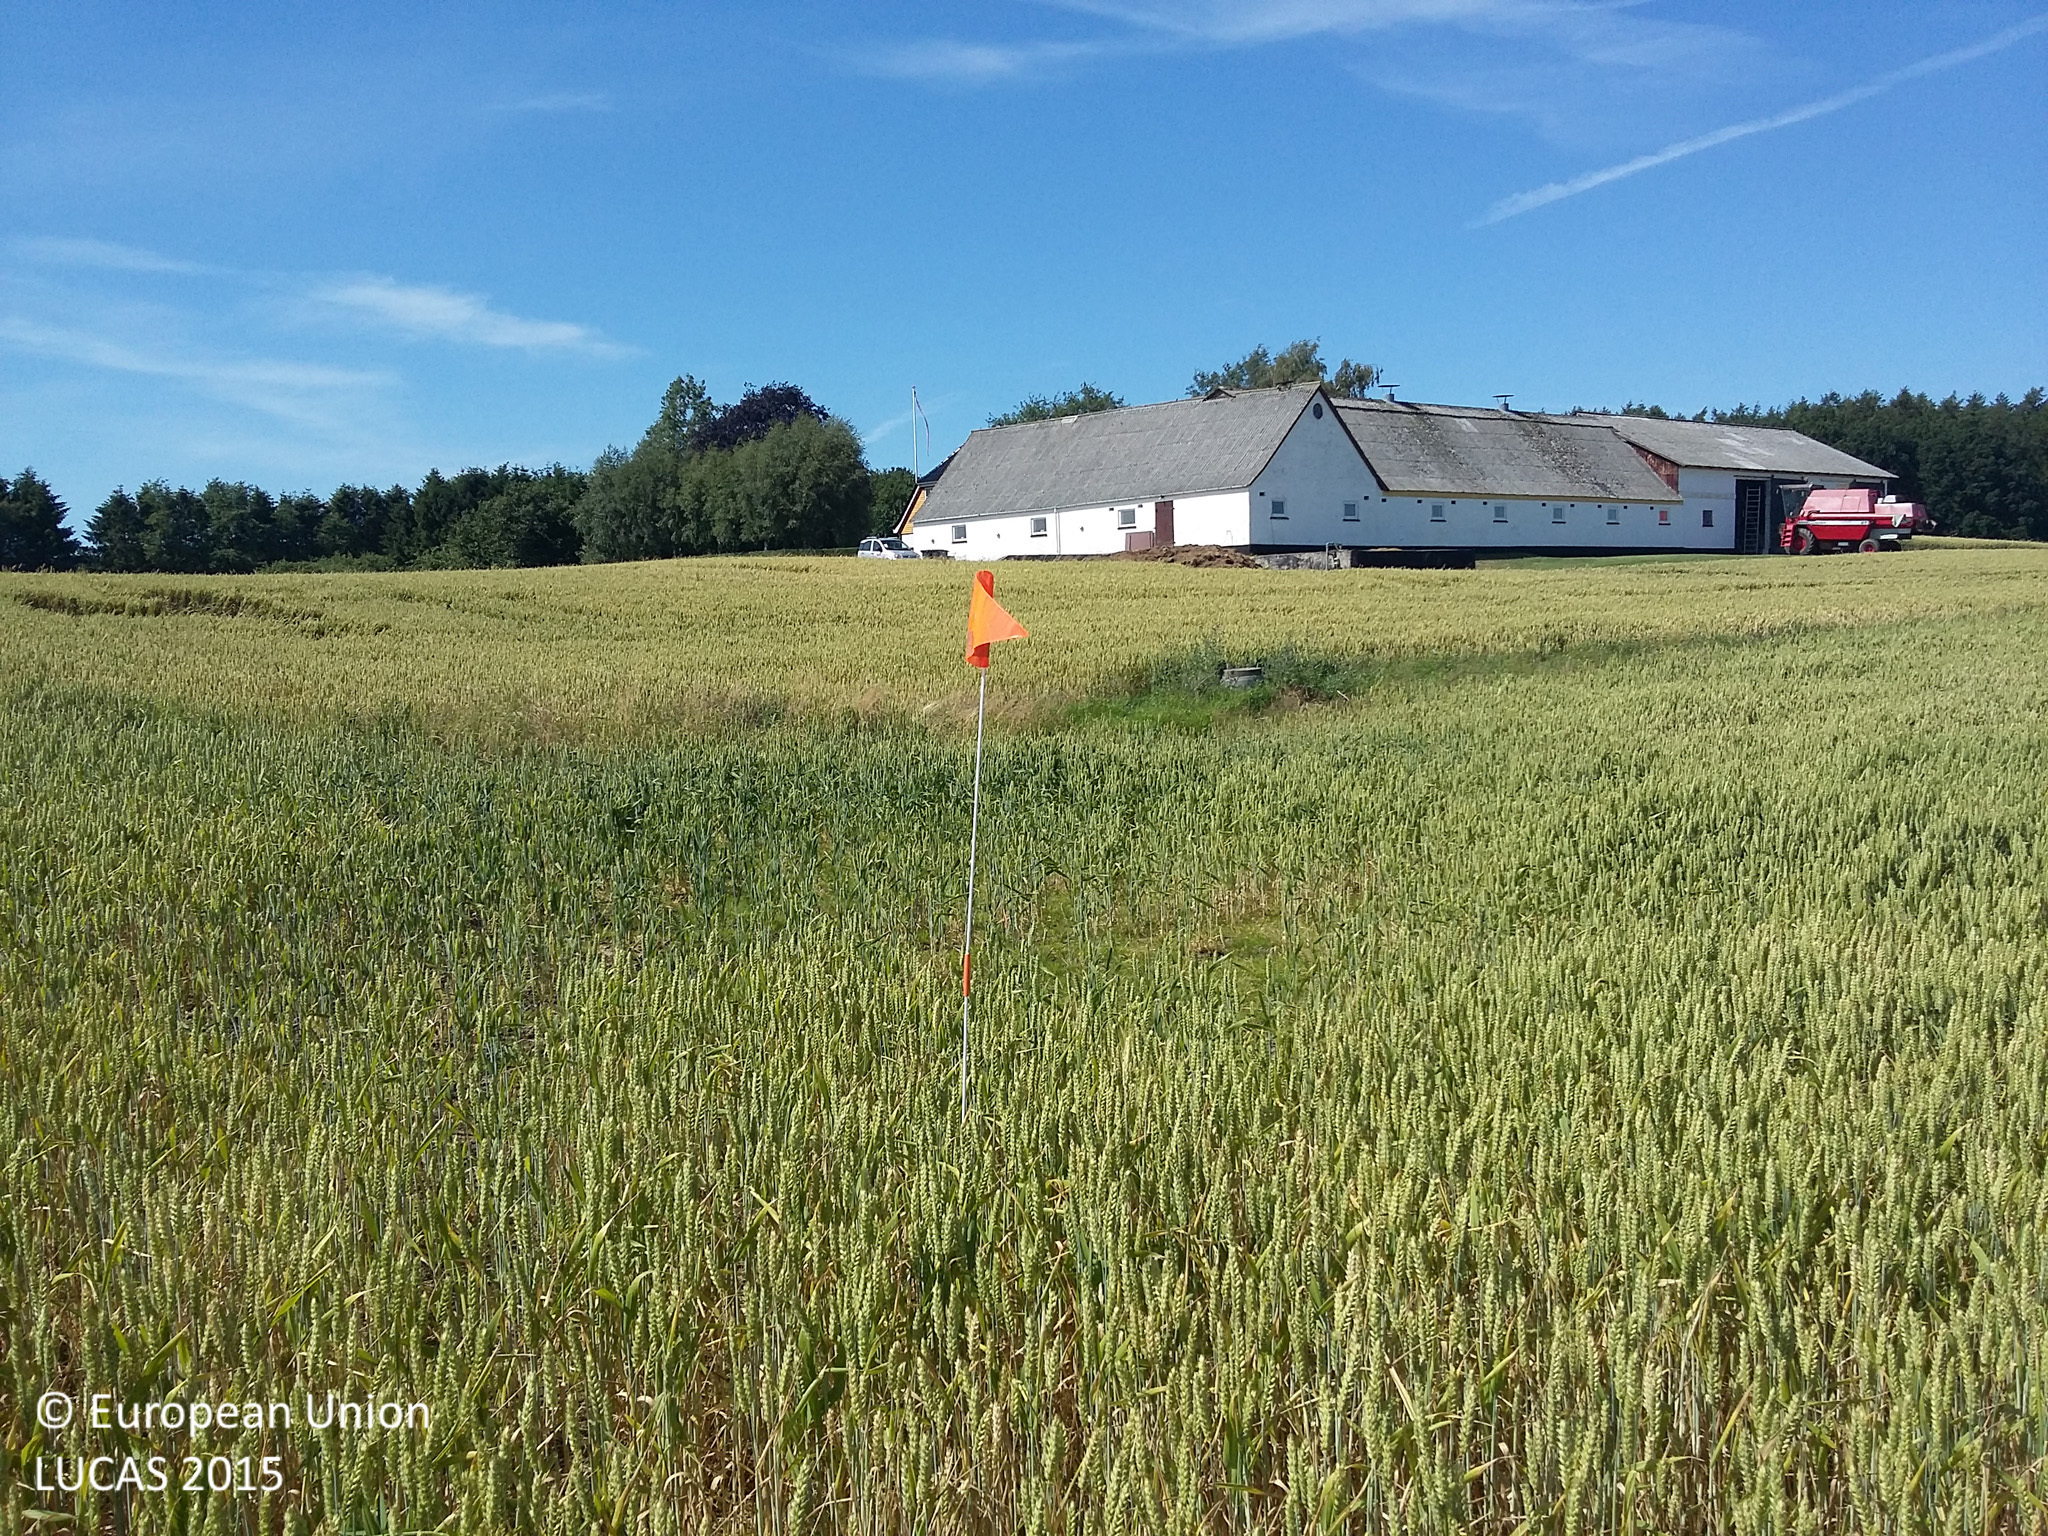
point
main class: Cropland
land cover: Common wheat
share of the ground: > 75 %
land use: Agriculture (excluding fallow land and kitchen gardens)
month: July
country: DK
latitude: 55.6036
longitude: 11.5065
